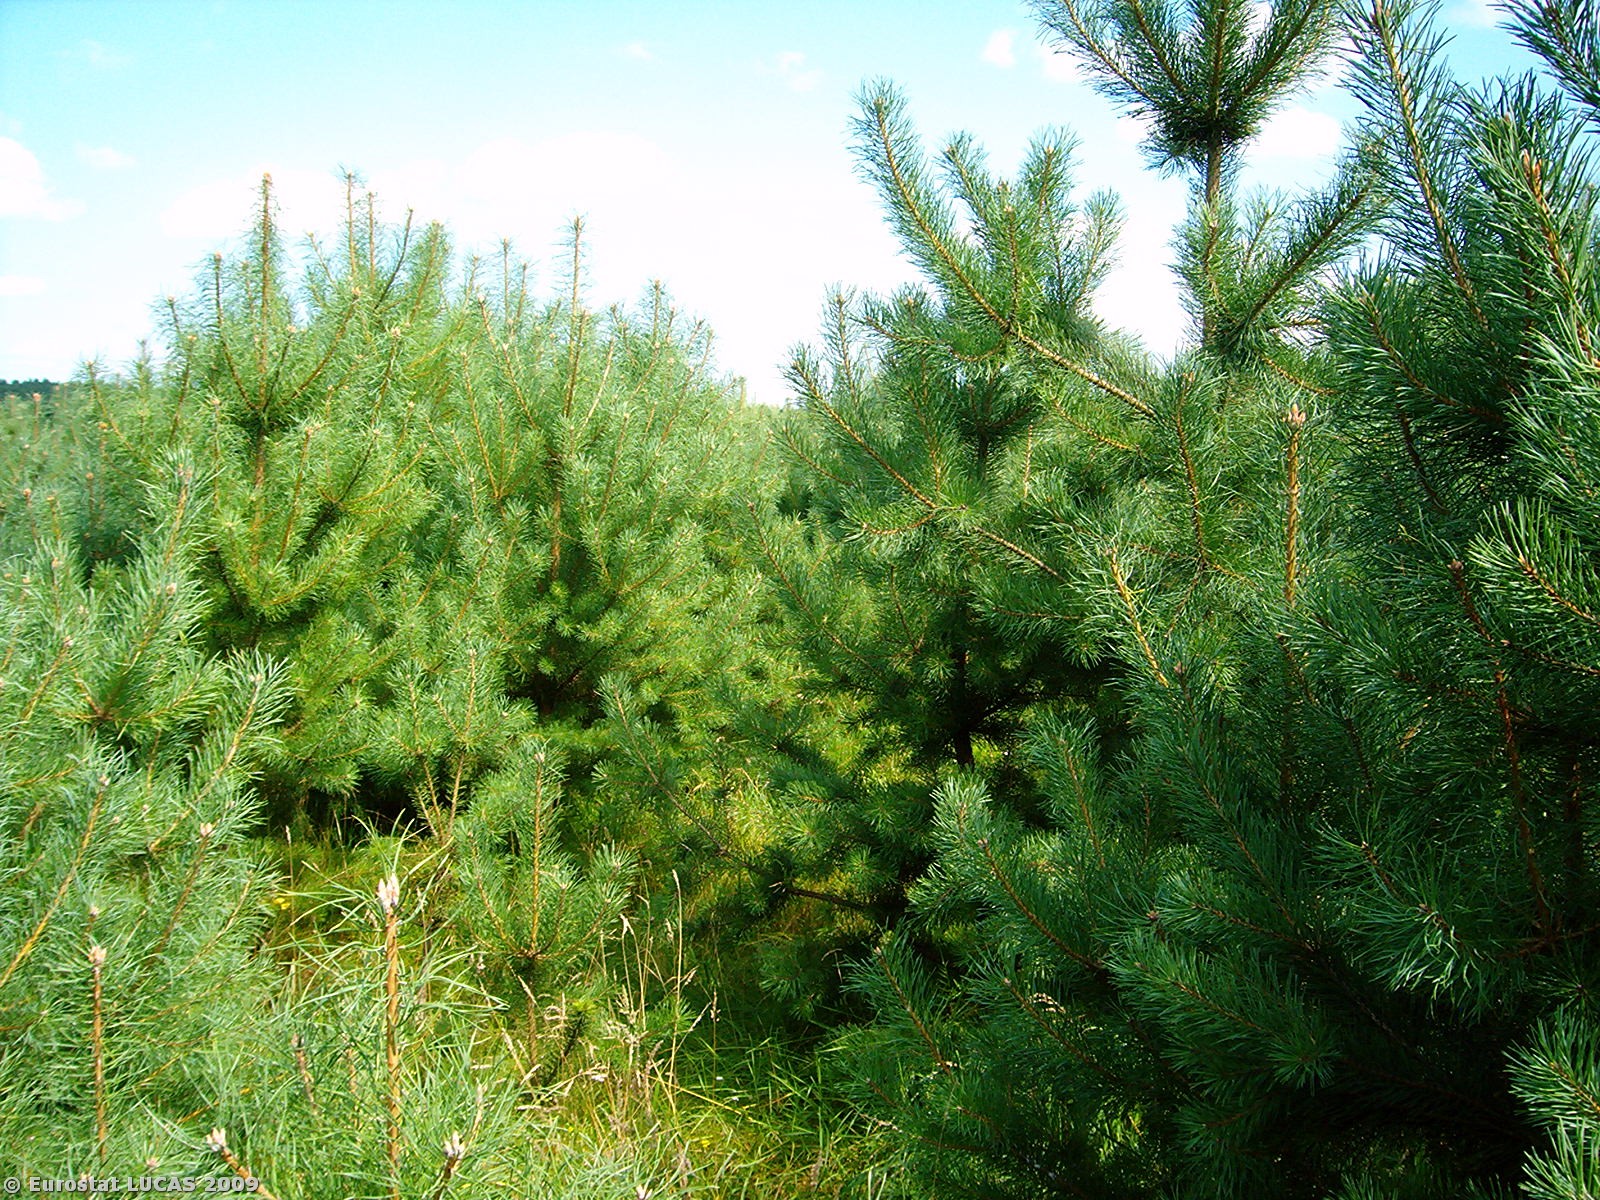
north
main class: Woodland
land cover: Coniferous woodland
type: hemiboreal forest and nemoral coniferous forest and mixed broadleaved-coniferous forest
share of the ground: > 75 %
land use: Forestry
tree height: > 5 m
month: August
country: PL
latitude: 52.9332
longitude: 15.9114
